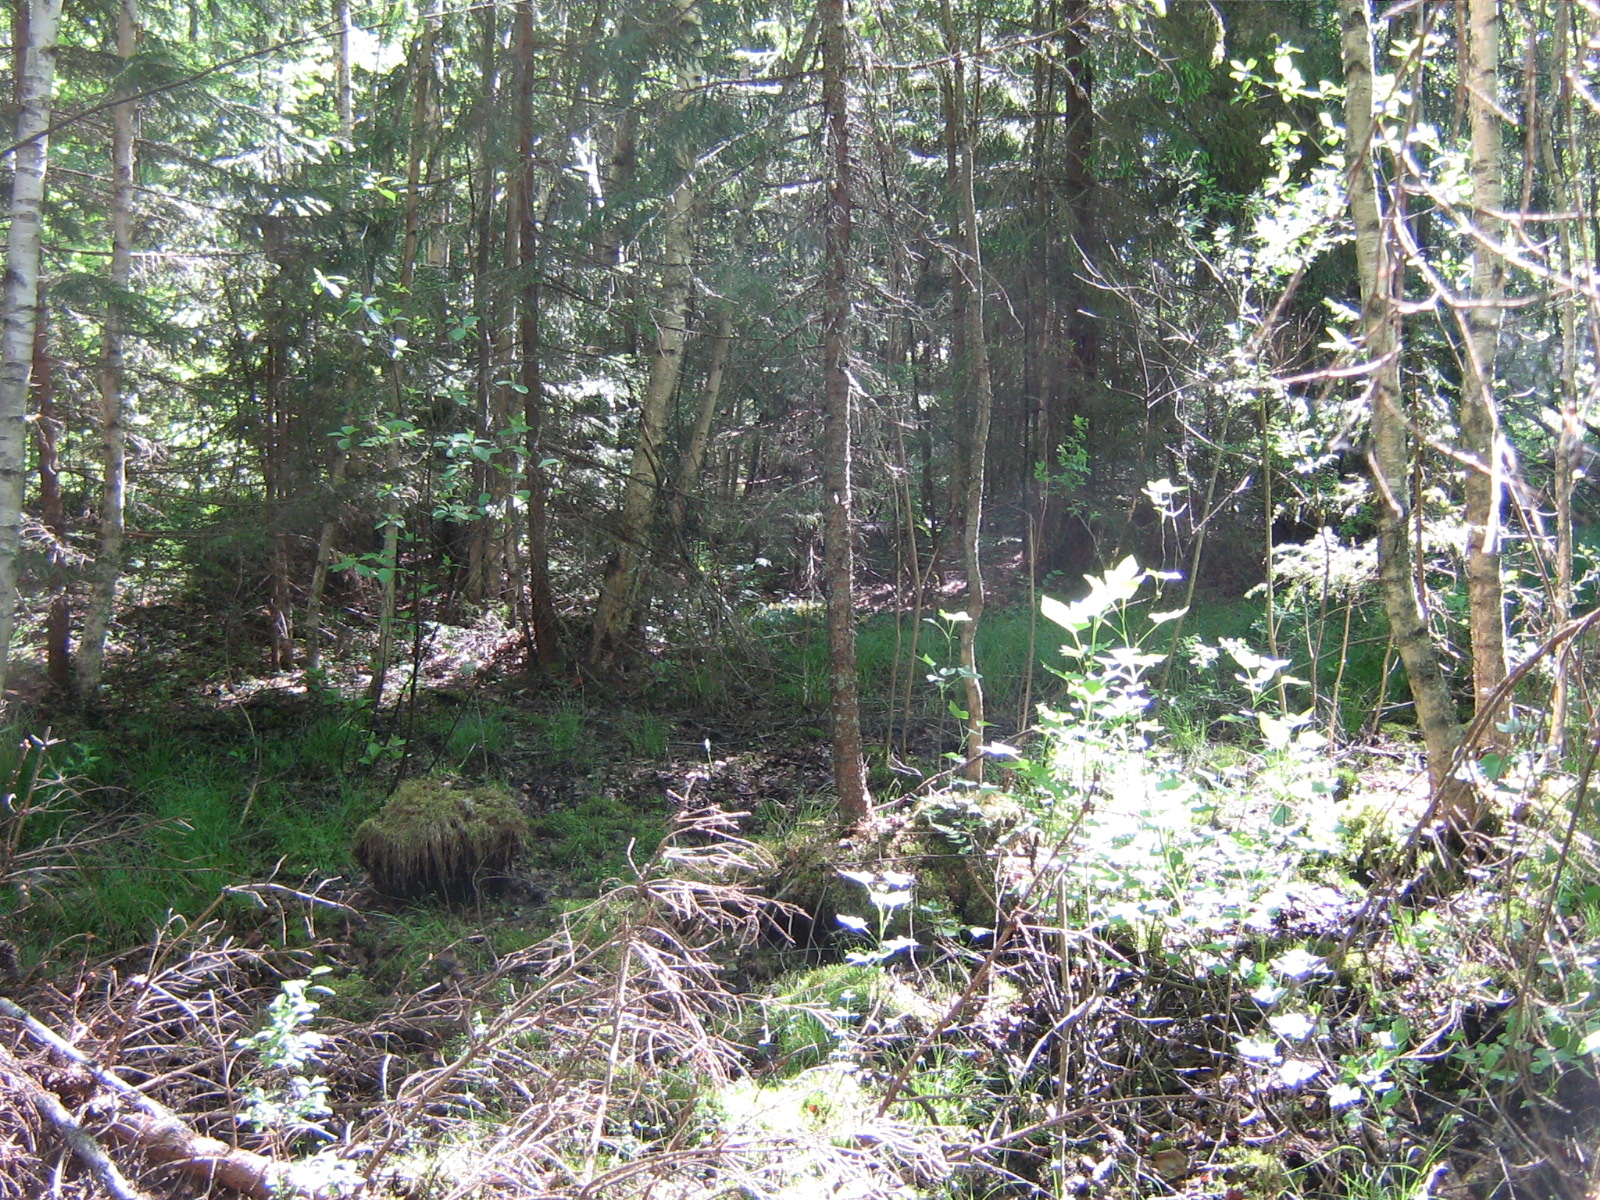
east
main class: Woodland
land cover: Spruce dominated mixed woodland
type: hemiboreal forest and nemoral coniferous forest and mixed broadleaved-coniferous forest
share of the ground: > 75 %
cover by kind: coniferous forest trees 60 %, broadleaved forest trees 40 %
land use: Forestry
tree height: > 5 m
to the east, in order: Spruce dominated mixed woodland; Broadleaved woodland; Artificial constructions; Grassland without tree/shrub cover; Broadleaved woodland
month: June
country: LV
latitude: 57.0777
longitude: 25.9161
